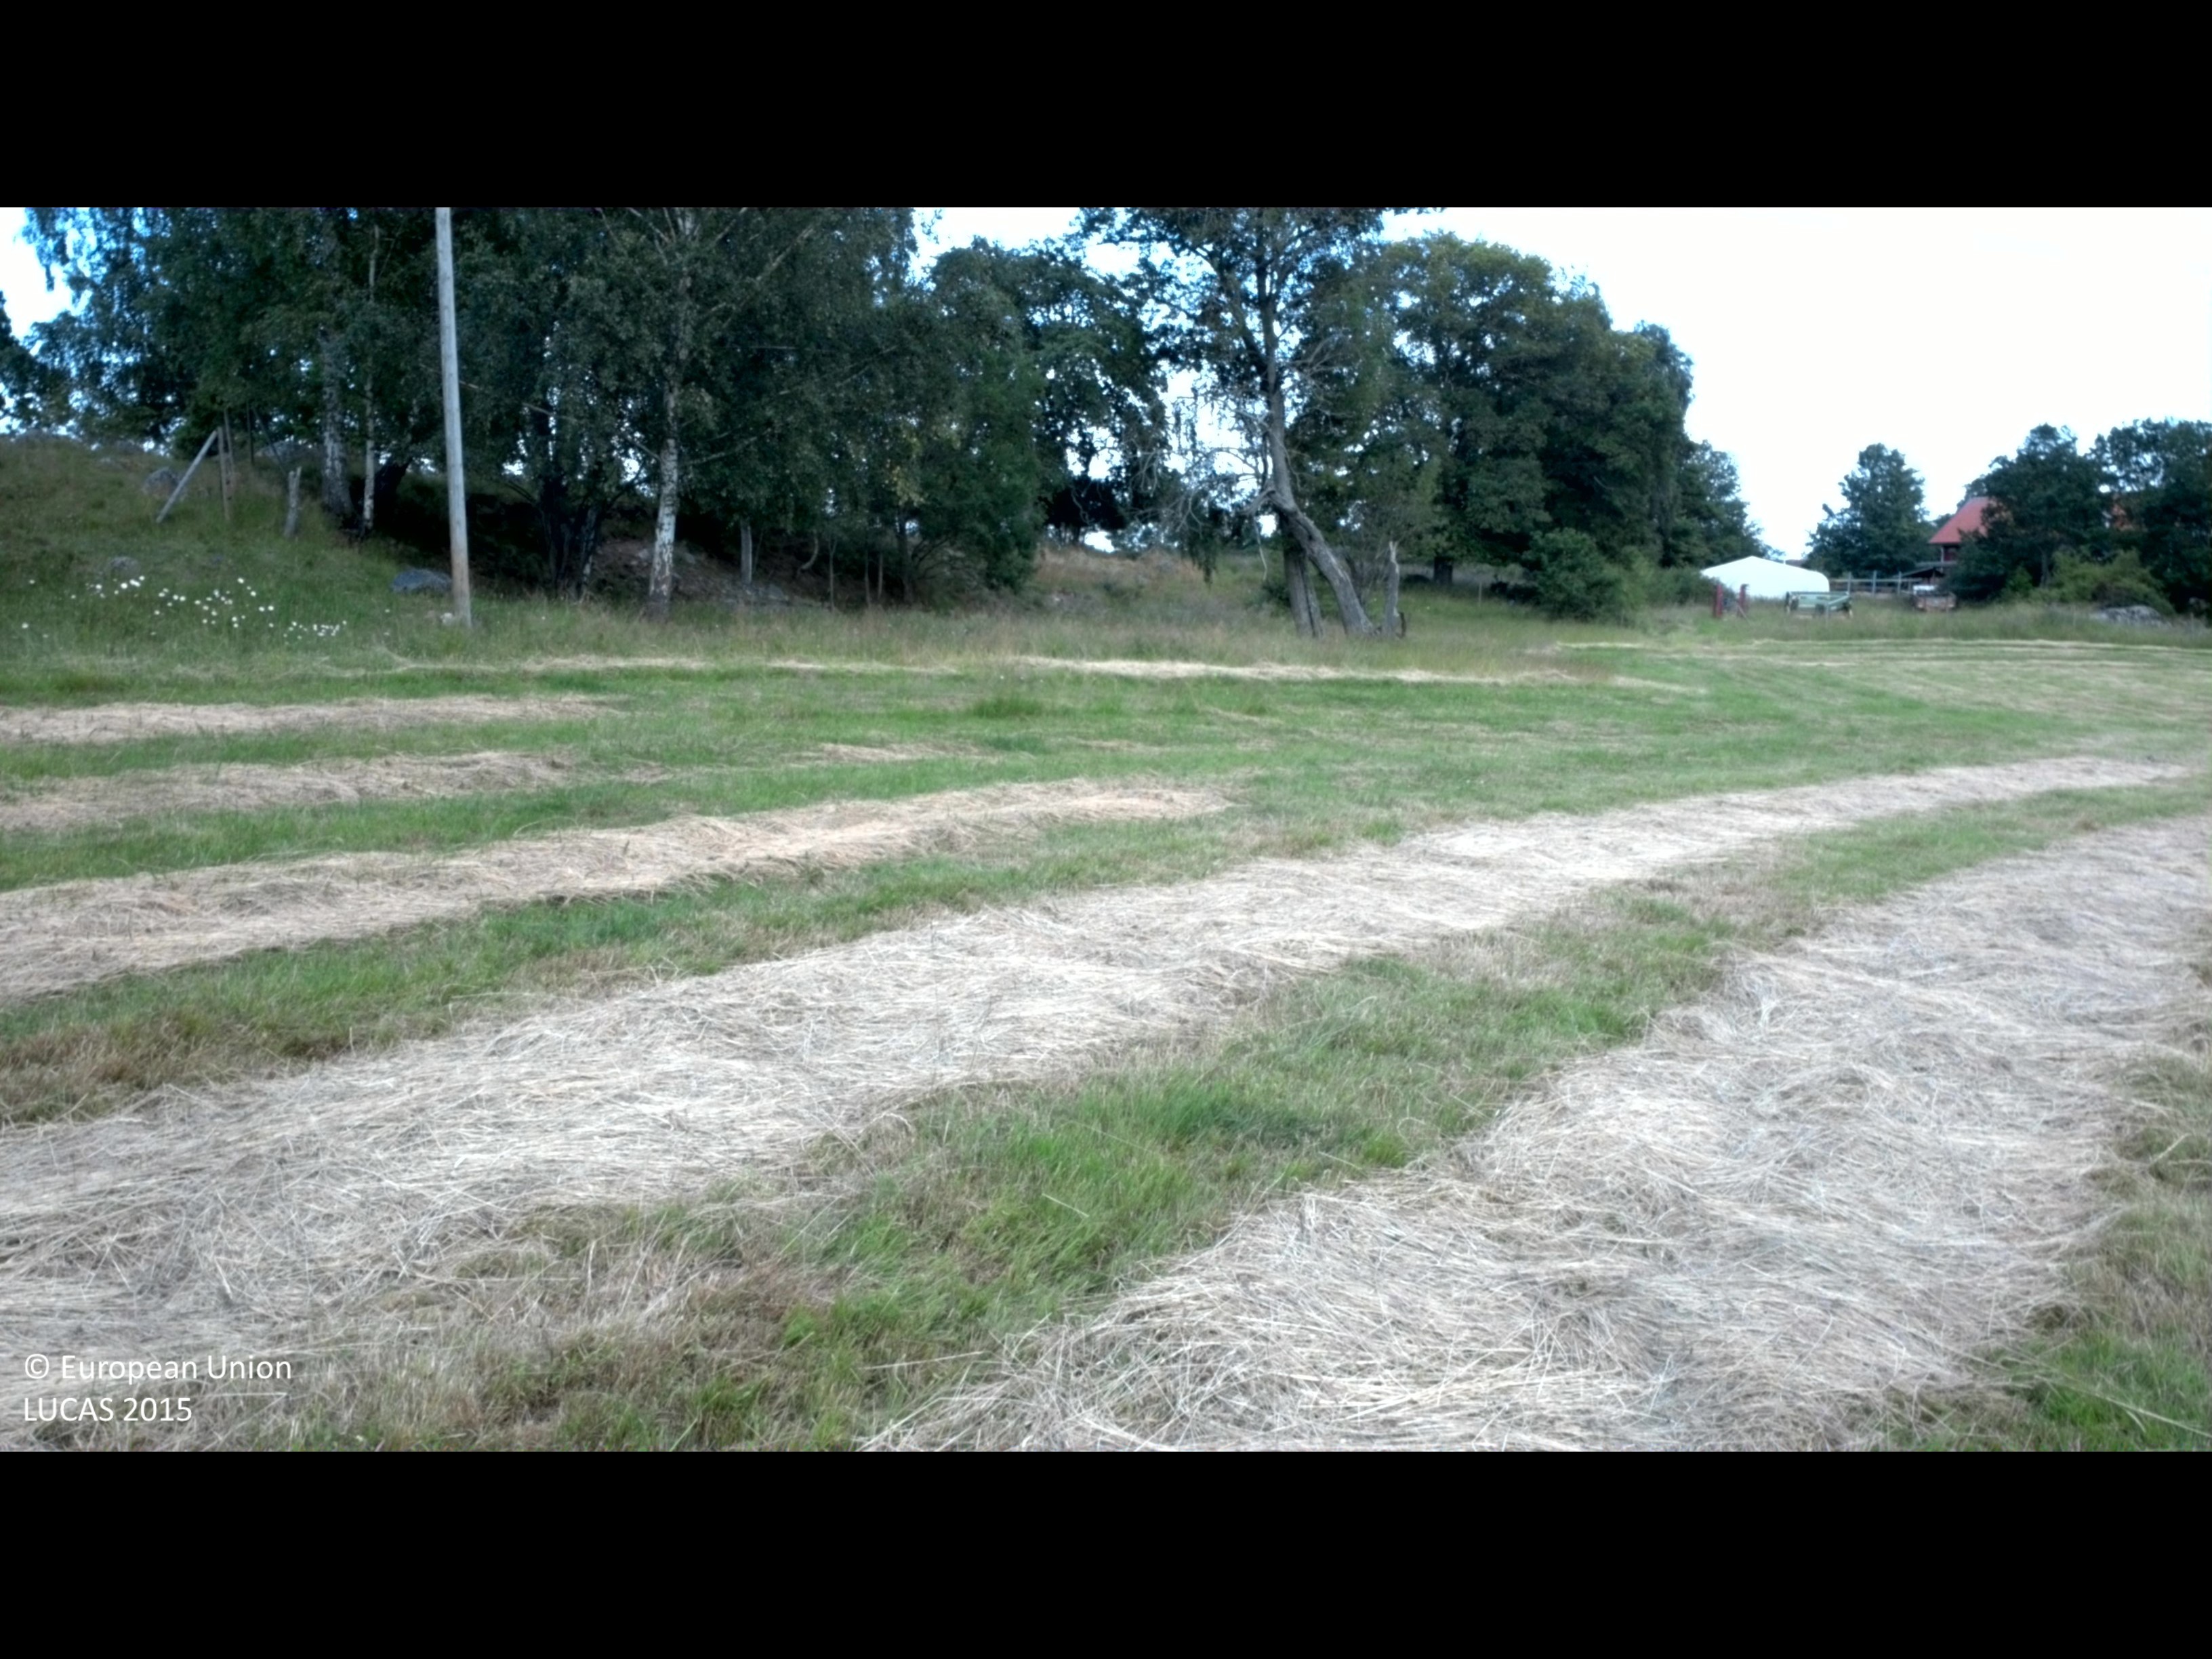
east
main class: Cropland
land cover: Other leguminous and mixtures for fodder
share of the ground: > 75 %
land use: Agriculture (excluding fallow land and kitchen gardens)
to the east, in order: Other leguminous and mixtures for fodder; Electric lines; Broadleaved woodland; Fences; Broadleaved woodland; Grassland with sparse tree/shrub cover; Broadleaved woodland; Salt marshes
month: July
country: SE
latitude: 58.4158
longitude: 16.6558
